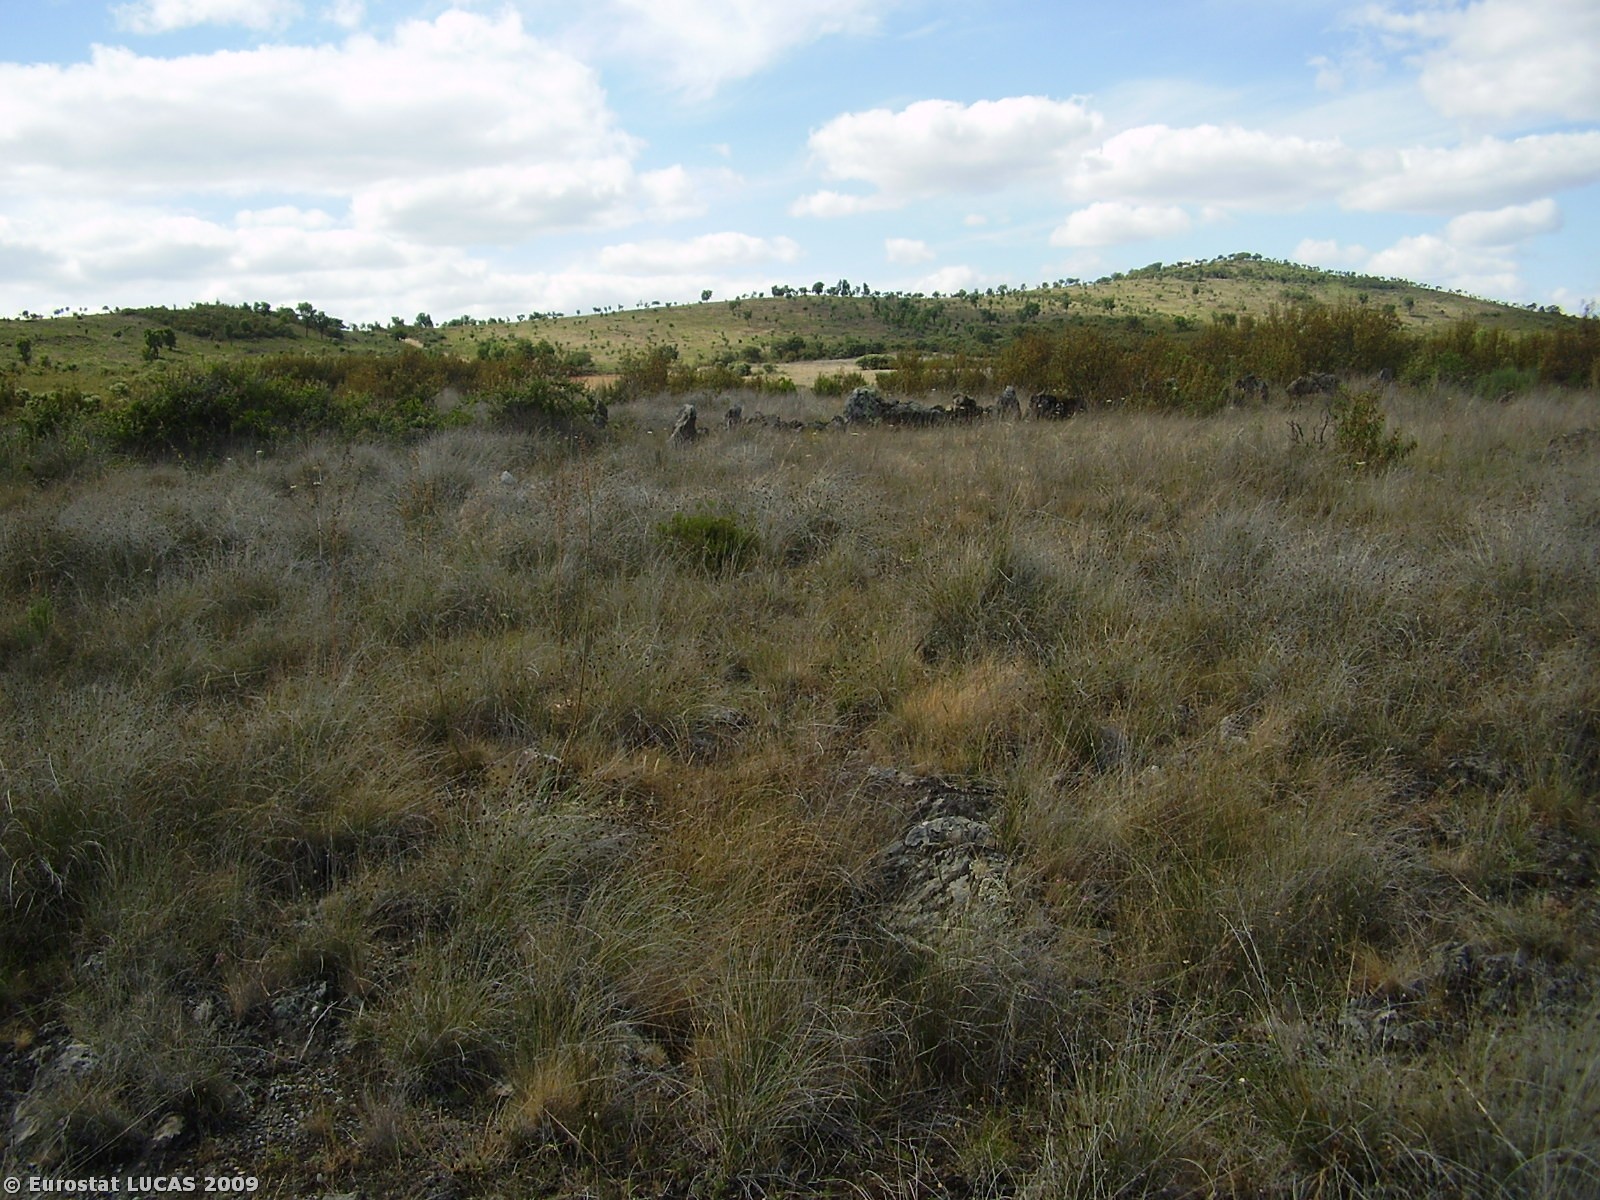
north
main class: Grassland
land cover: Spontaneously vegetated surfaces
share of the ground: > 75 %
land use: Fallow land
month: June
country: PT
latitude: 41.5013
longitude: -6.7729
